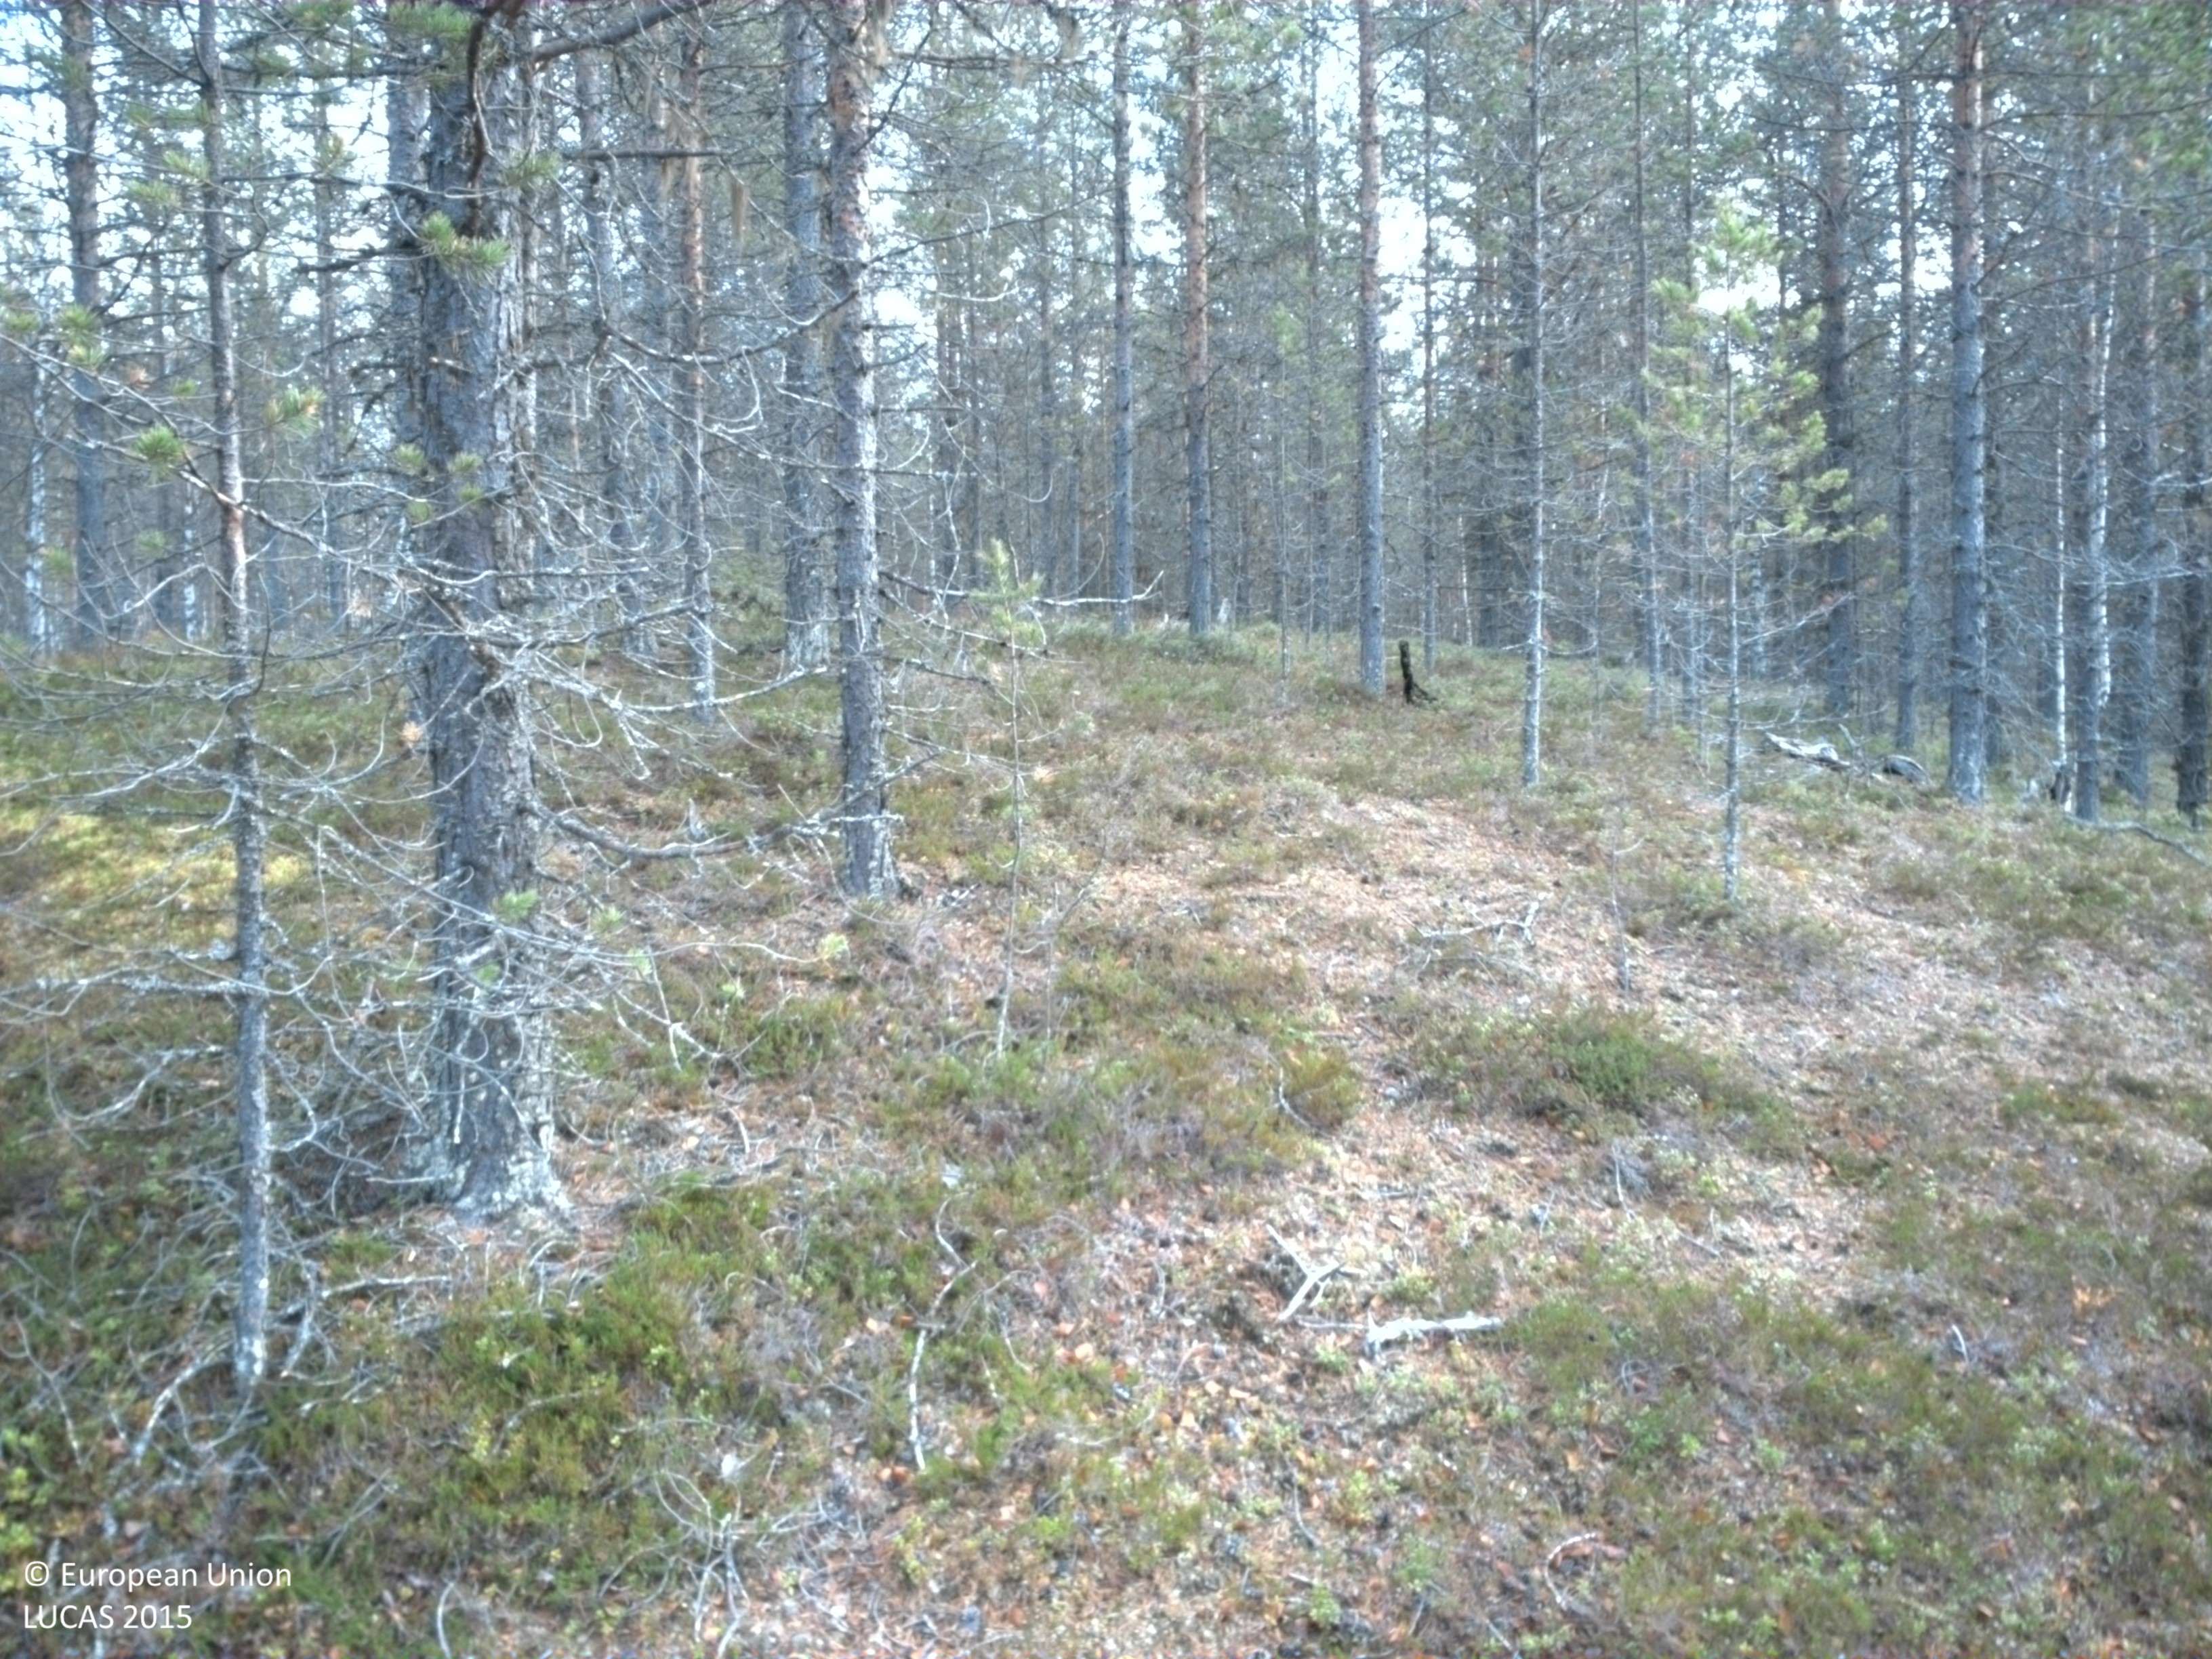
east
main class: Woodland
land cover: Pine dominated coniferous woodland
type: boreal forest
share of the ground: 25 - 50 %
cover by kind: shrubs 45 %, coniferous forest trees 30 %, lichens and mosses 15 %, broadleaved forest trees 5 %, herbaceous plants 5 %
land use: Forestry
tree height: > 5 m
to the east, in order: Pine dominated coniferous woodland; Pine dominated mixed woodland; Pine dominated coniferous woodland
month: October
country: SE
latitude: 64.6329
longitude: 16.8075
